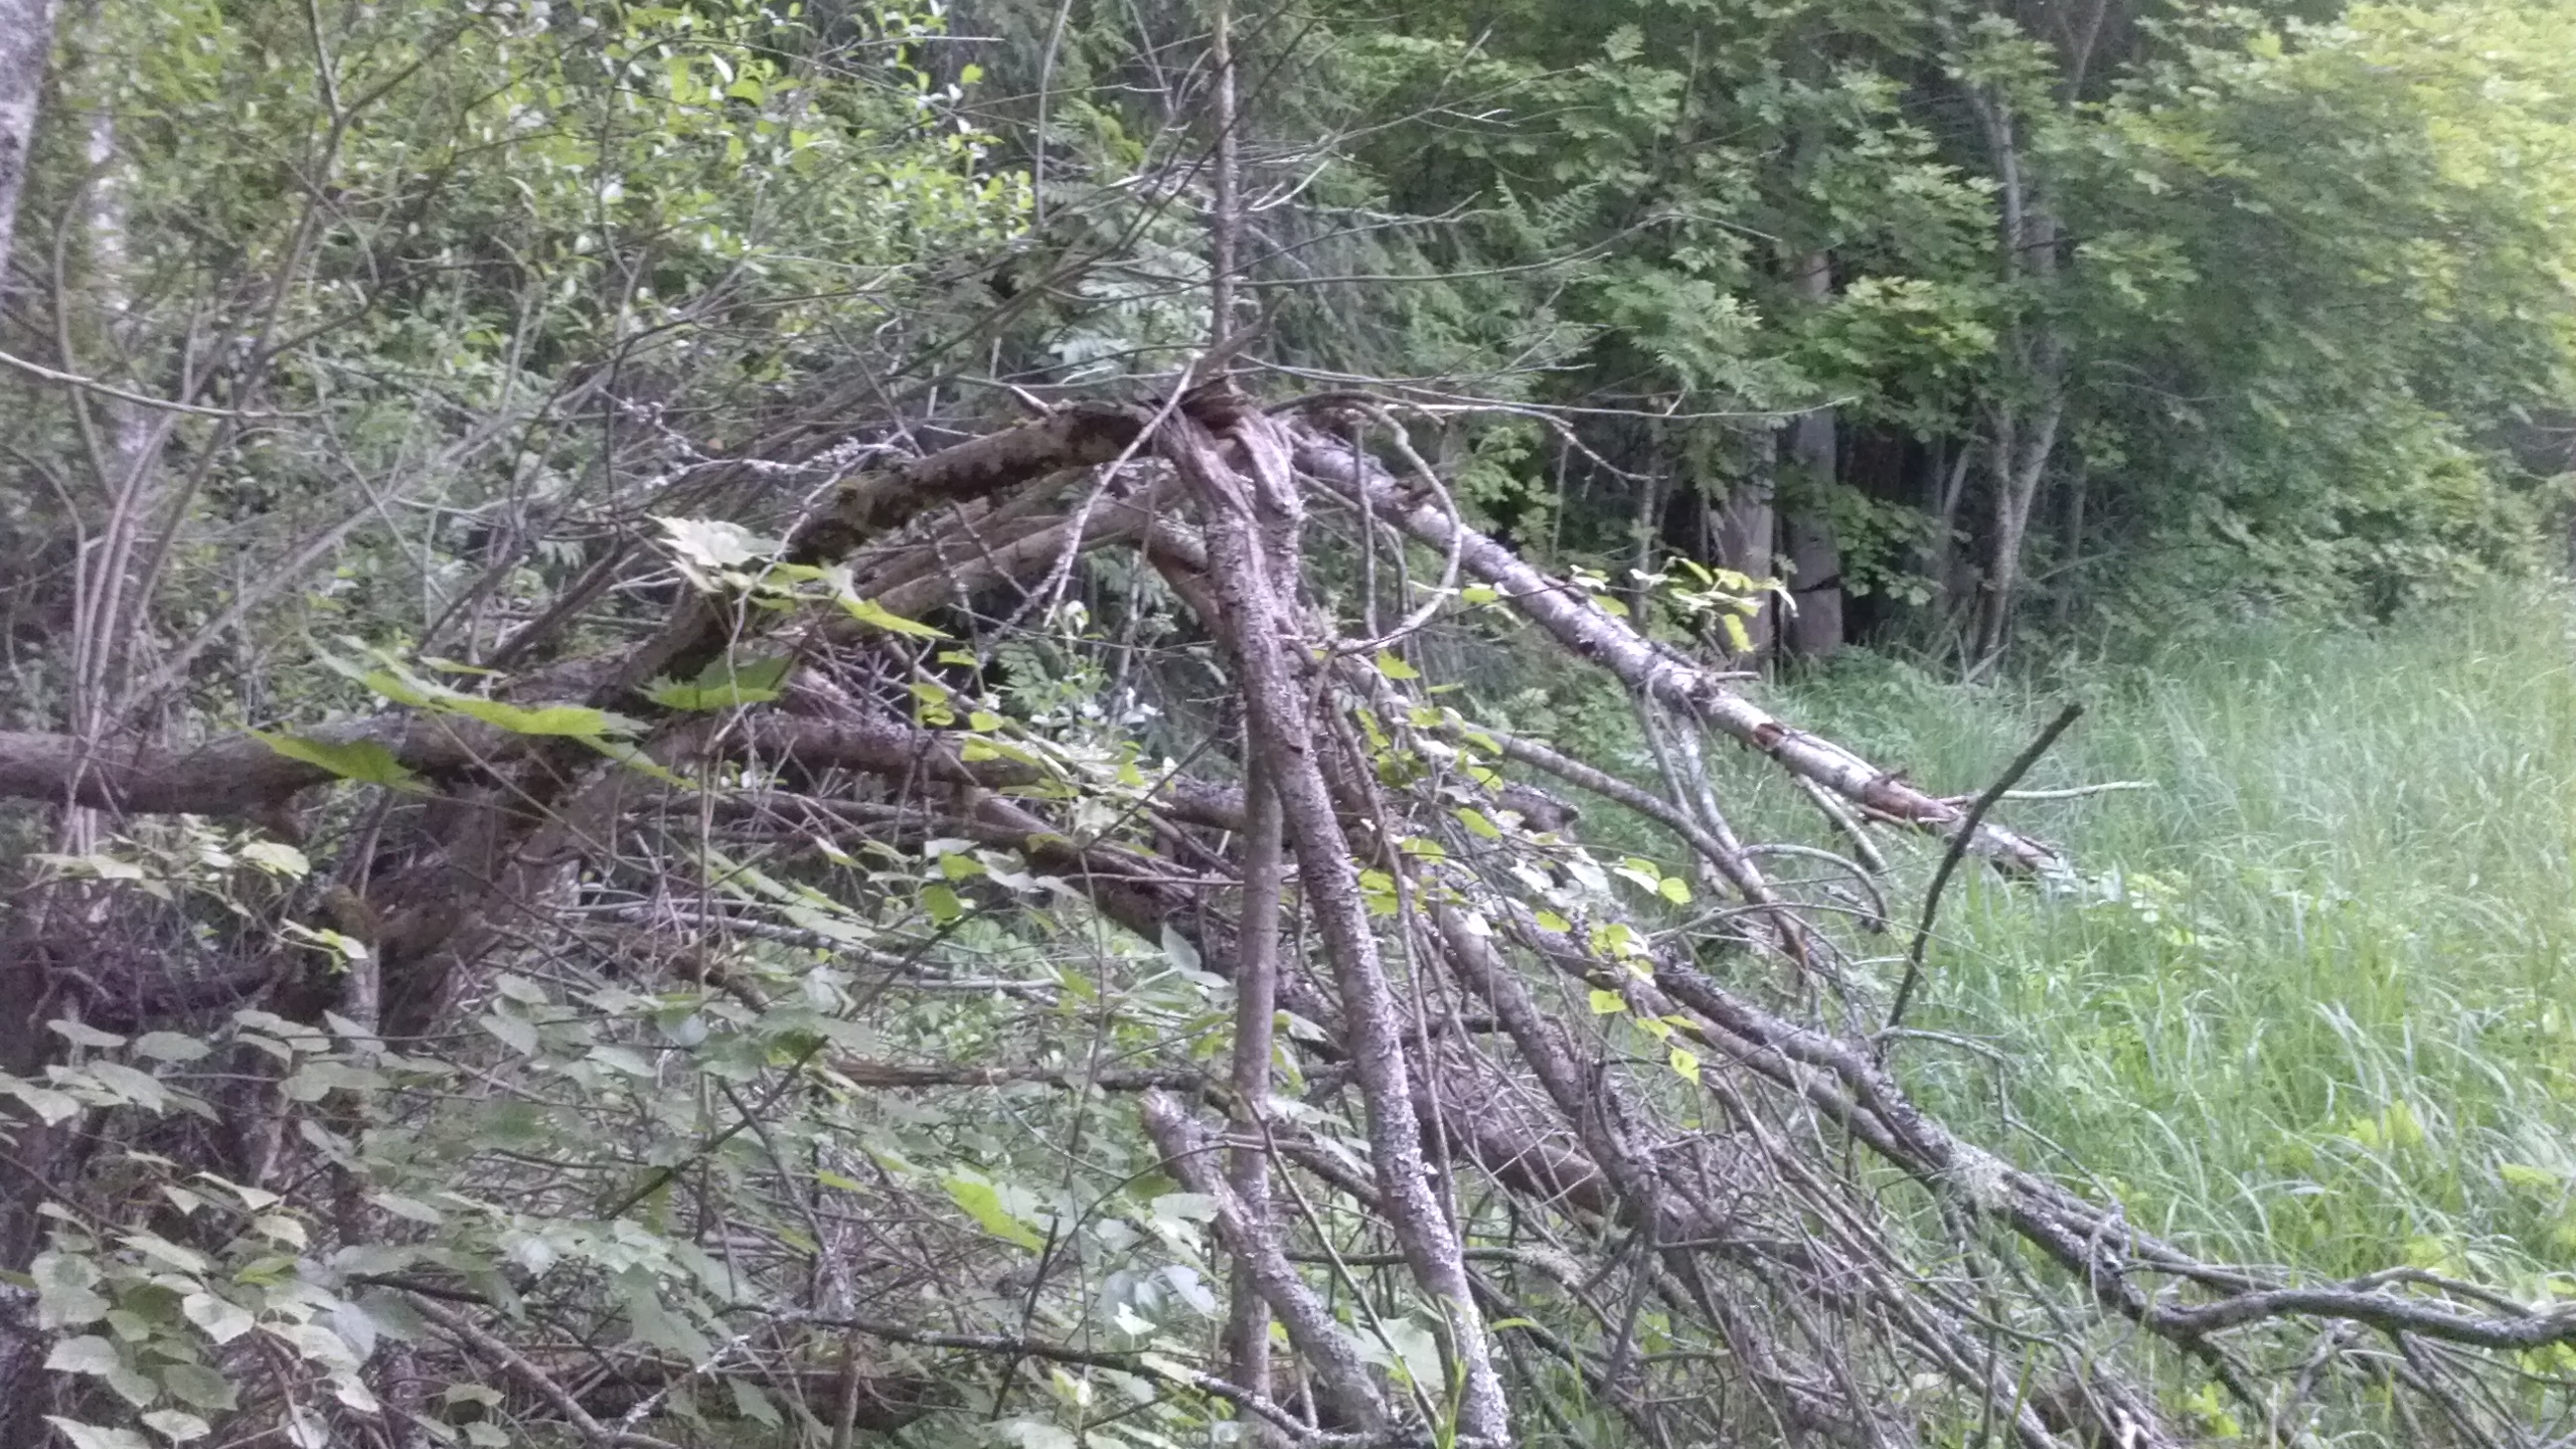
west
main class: Woodland
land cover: Spruce dominated mixed woodland
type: hemiboreal forest and nemoral coniferous forest and mixed broadleaved-coniferous forest
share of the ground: > 75 %
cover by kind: coniferous forest trees 65 %, broadleaved forest trees 25 %, shrubs 5 %, herbaceous plants 5 %
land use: Forestry
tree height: > 5 m
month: June
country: LV
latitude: 56.4485
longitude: 27.6238
